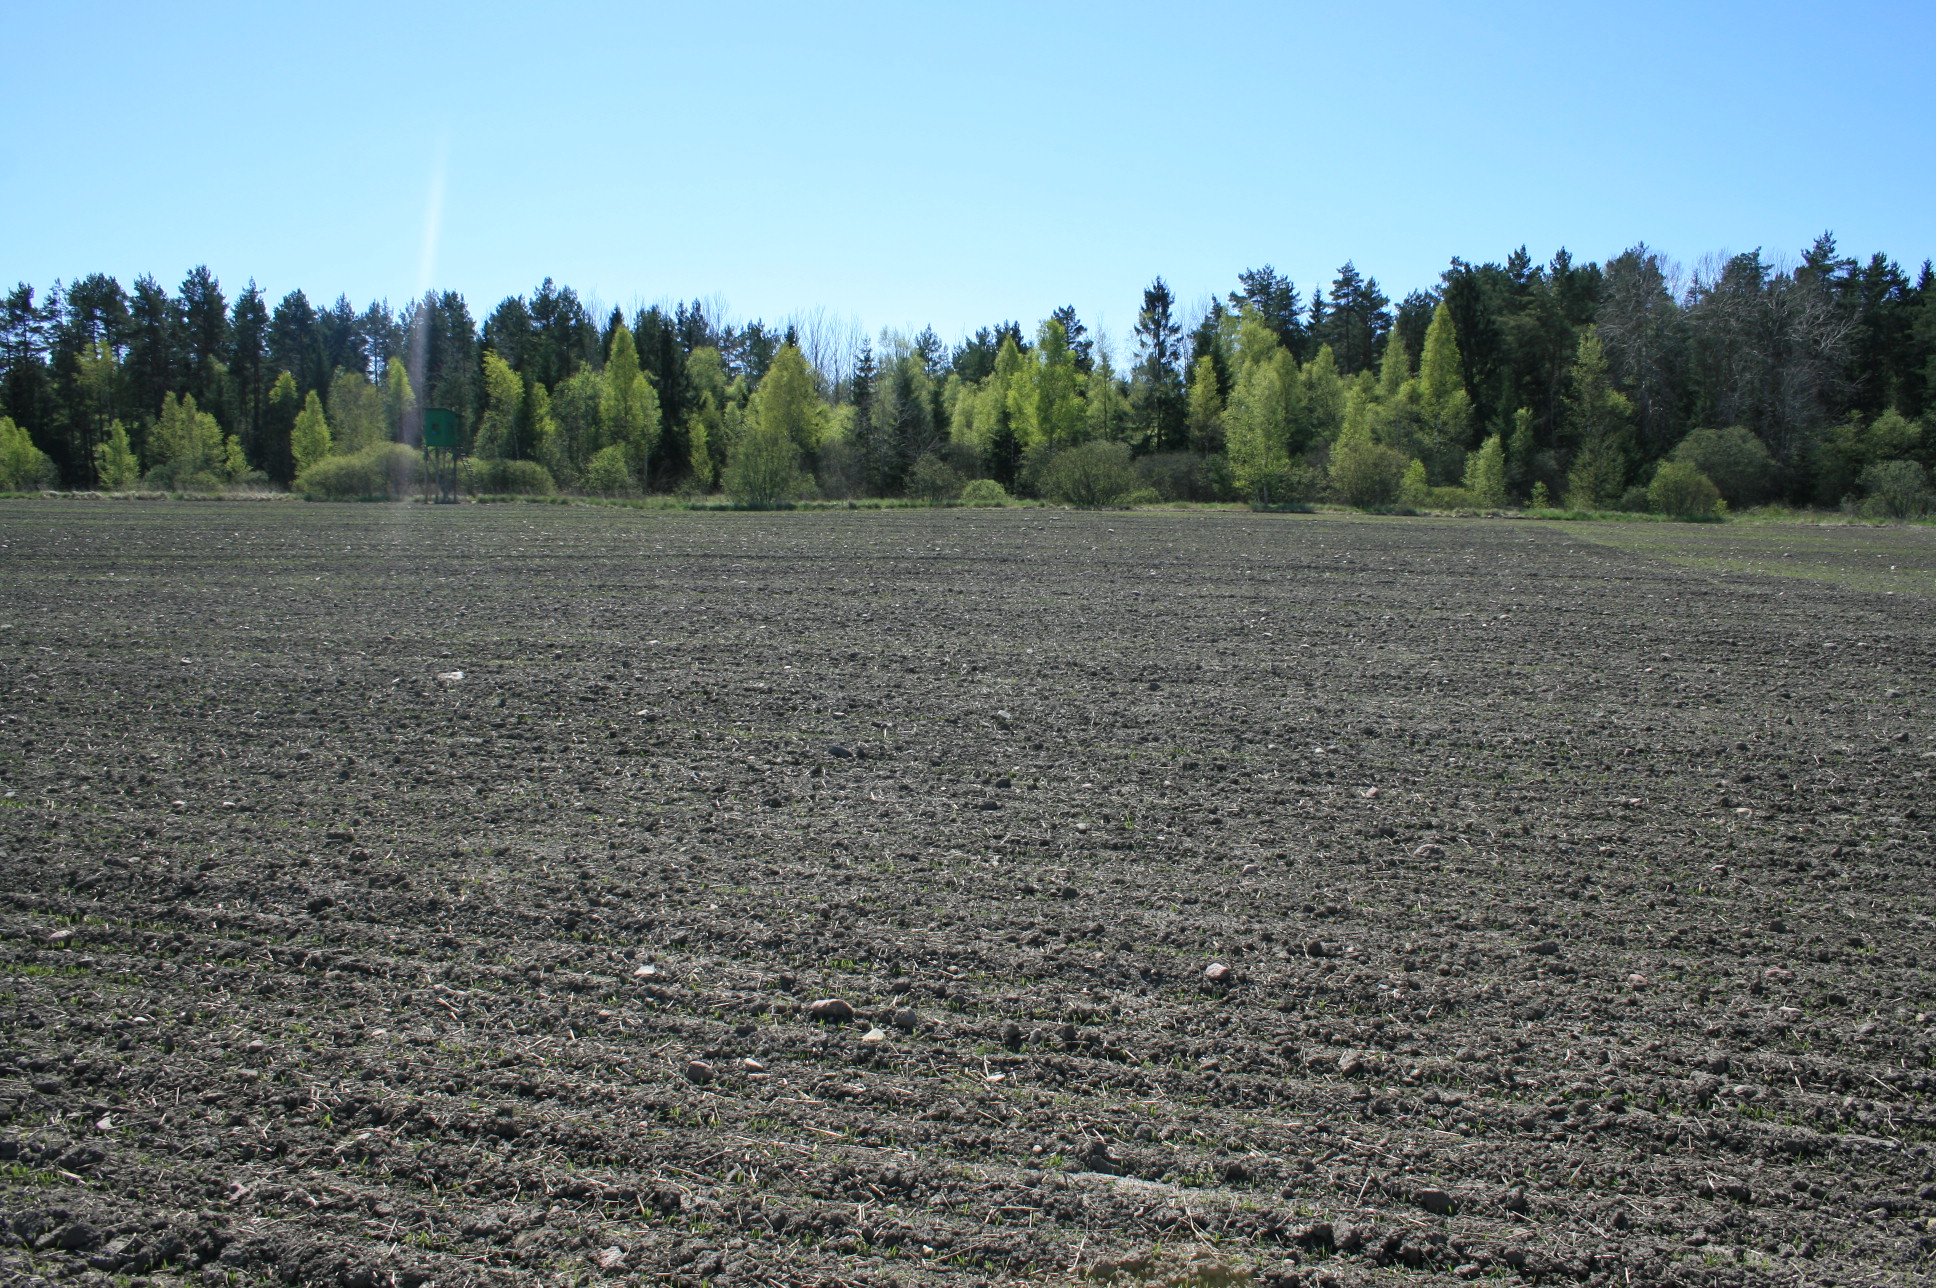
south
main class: Cropland
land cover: Common wheat
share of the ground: 10 - 25 %
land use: Agriculture (excluding fallow land and kitchen gardens)
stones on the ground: < 10 %
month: May
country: LT
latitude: 56.1010
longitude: 21.3436
